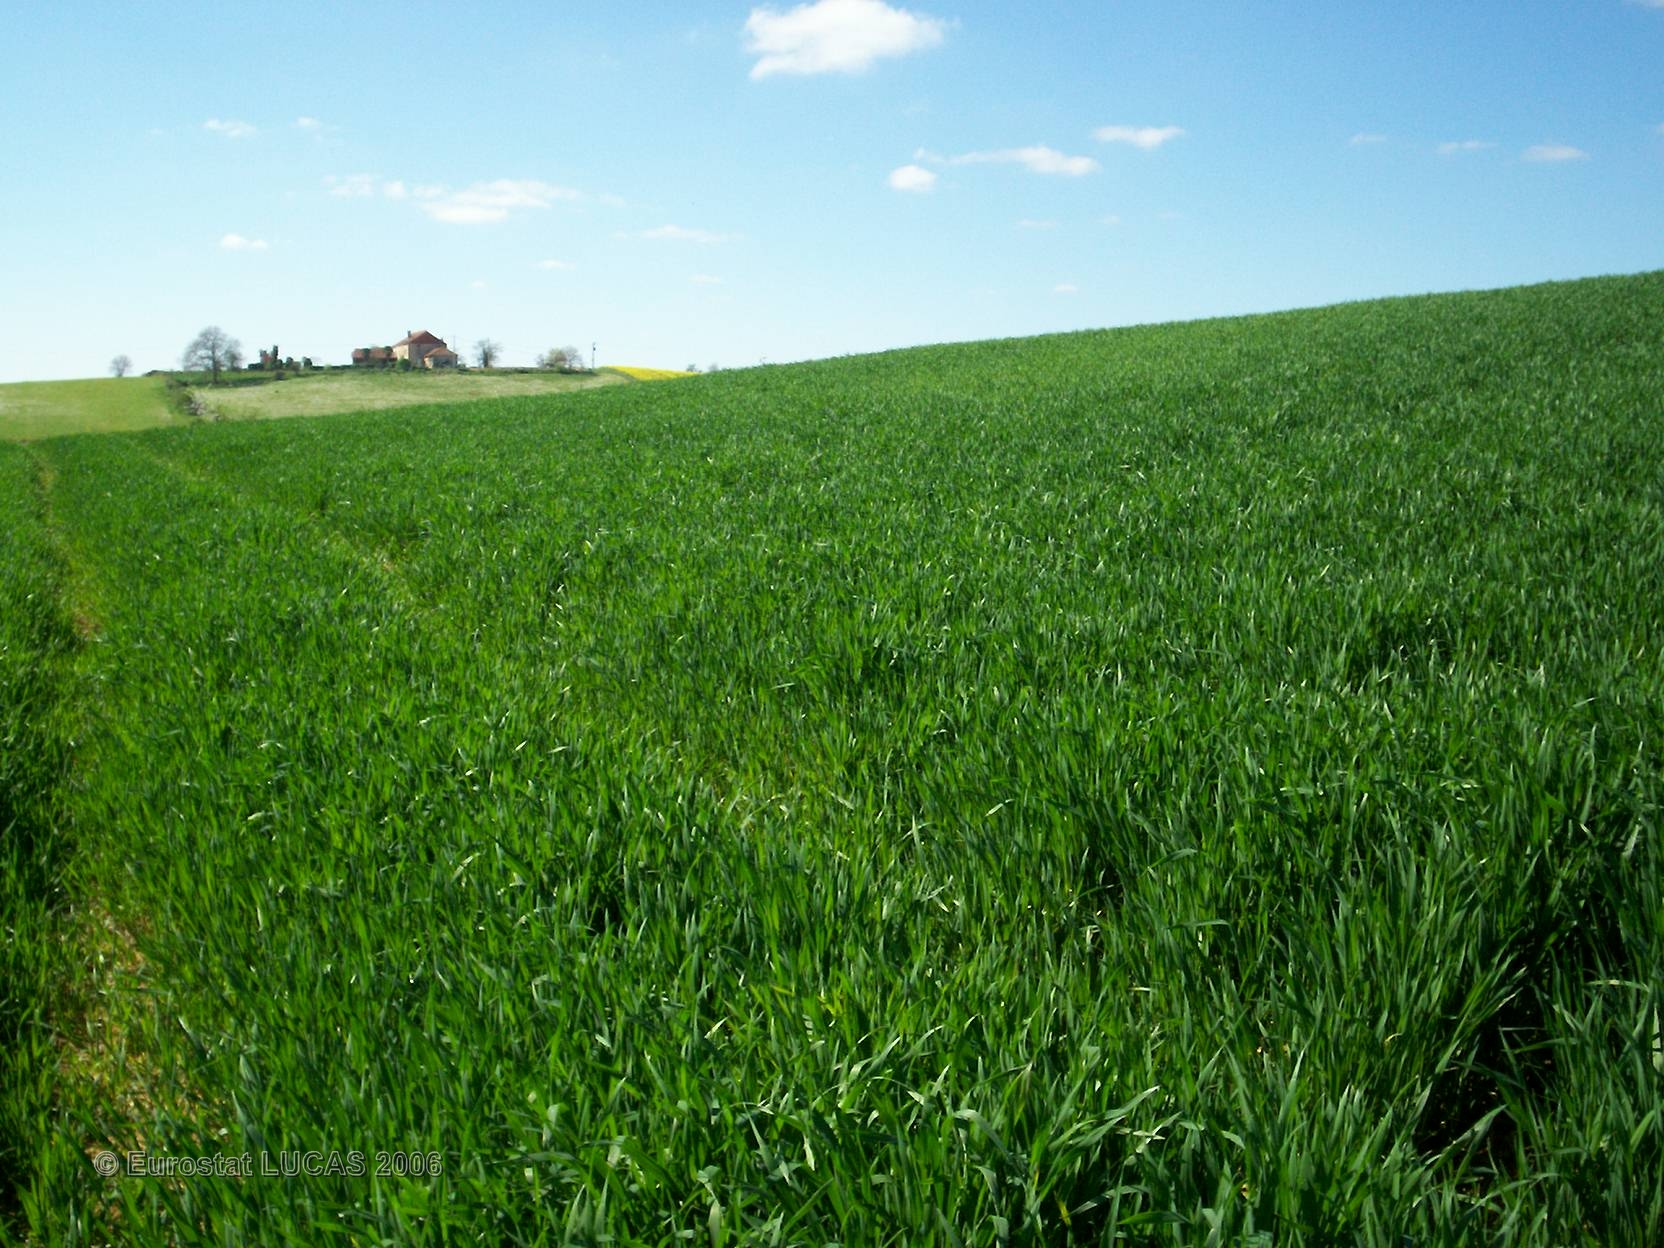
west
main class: Cropland
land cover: Common wheat
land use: Agriculture (excluding fallow land and kitchen gardens)
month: April
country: FR
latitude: 43.5233
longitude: 0.2096
